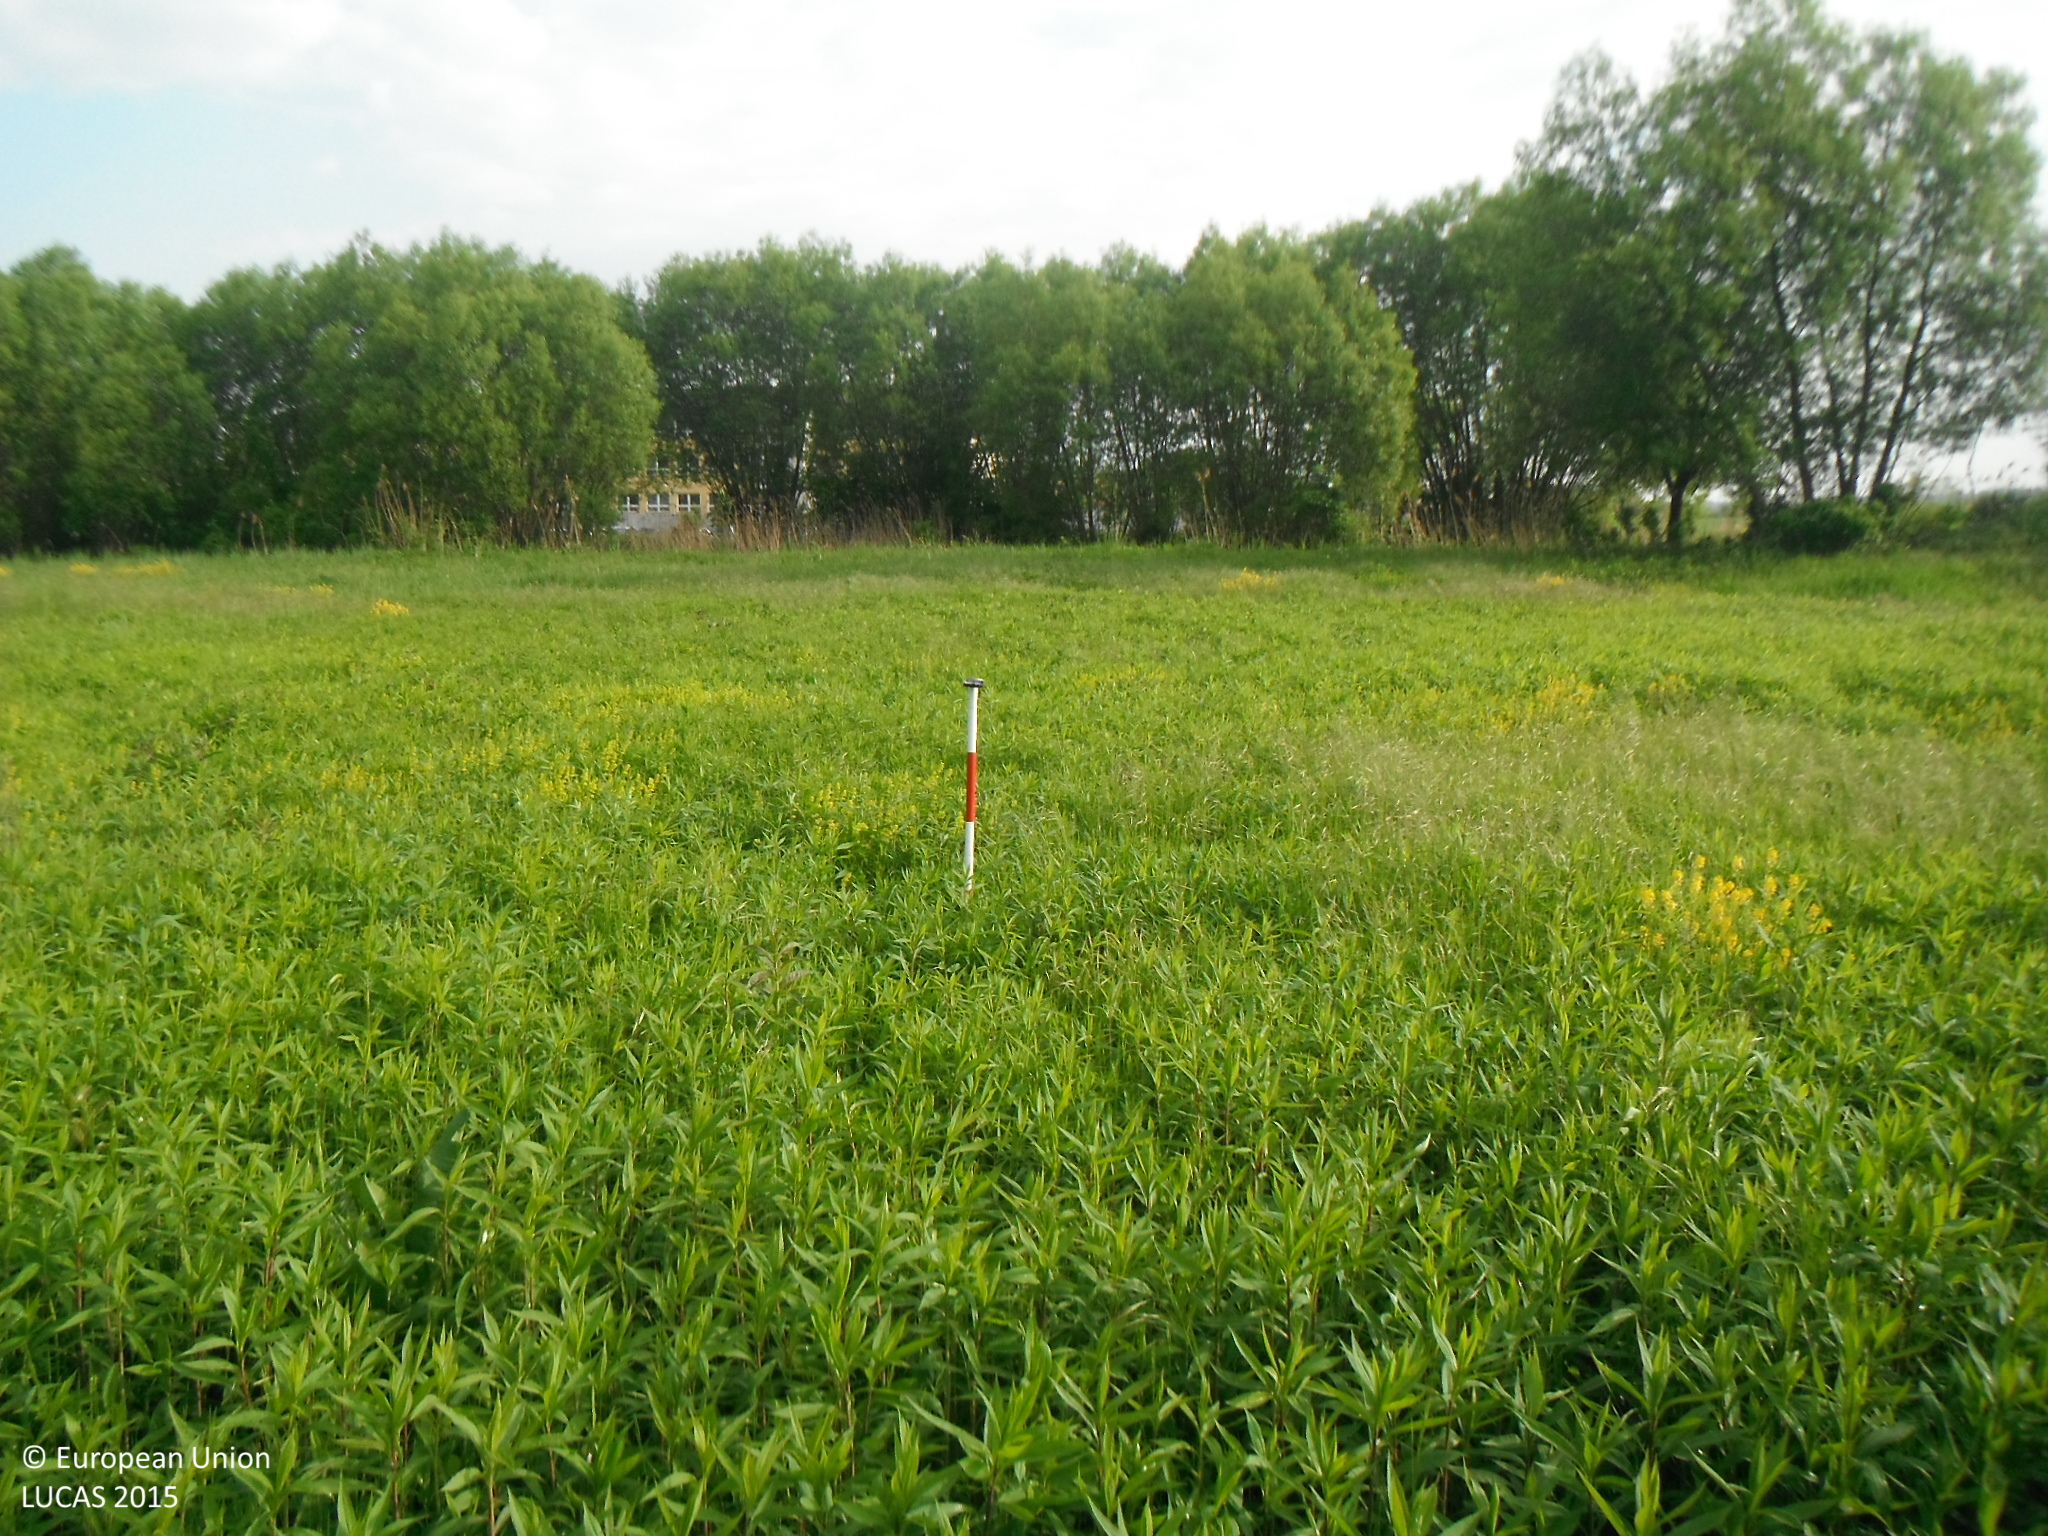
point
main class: Grassland
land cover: Spontaneously vegetated surfaces
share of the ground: > 75 %
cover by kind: herbaceous plants 100 %
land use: Semi-natural and natural areas not in use
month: May
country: SK
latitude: 48.3902
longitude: 17.1254
